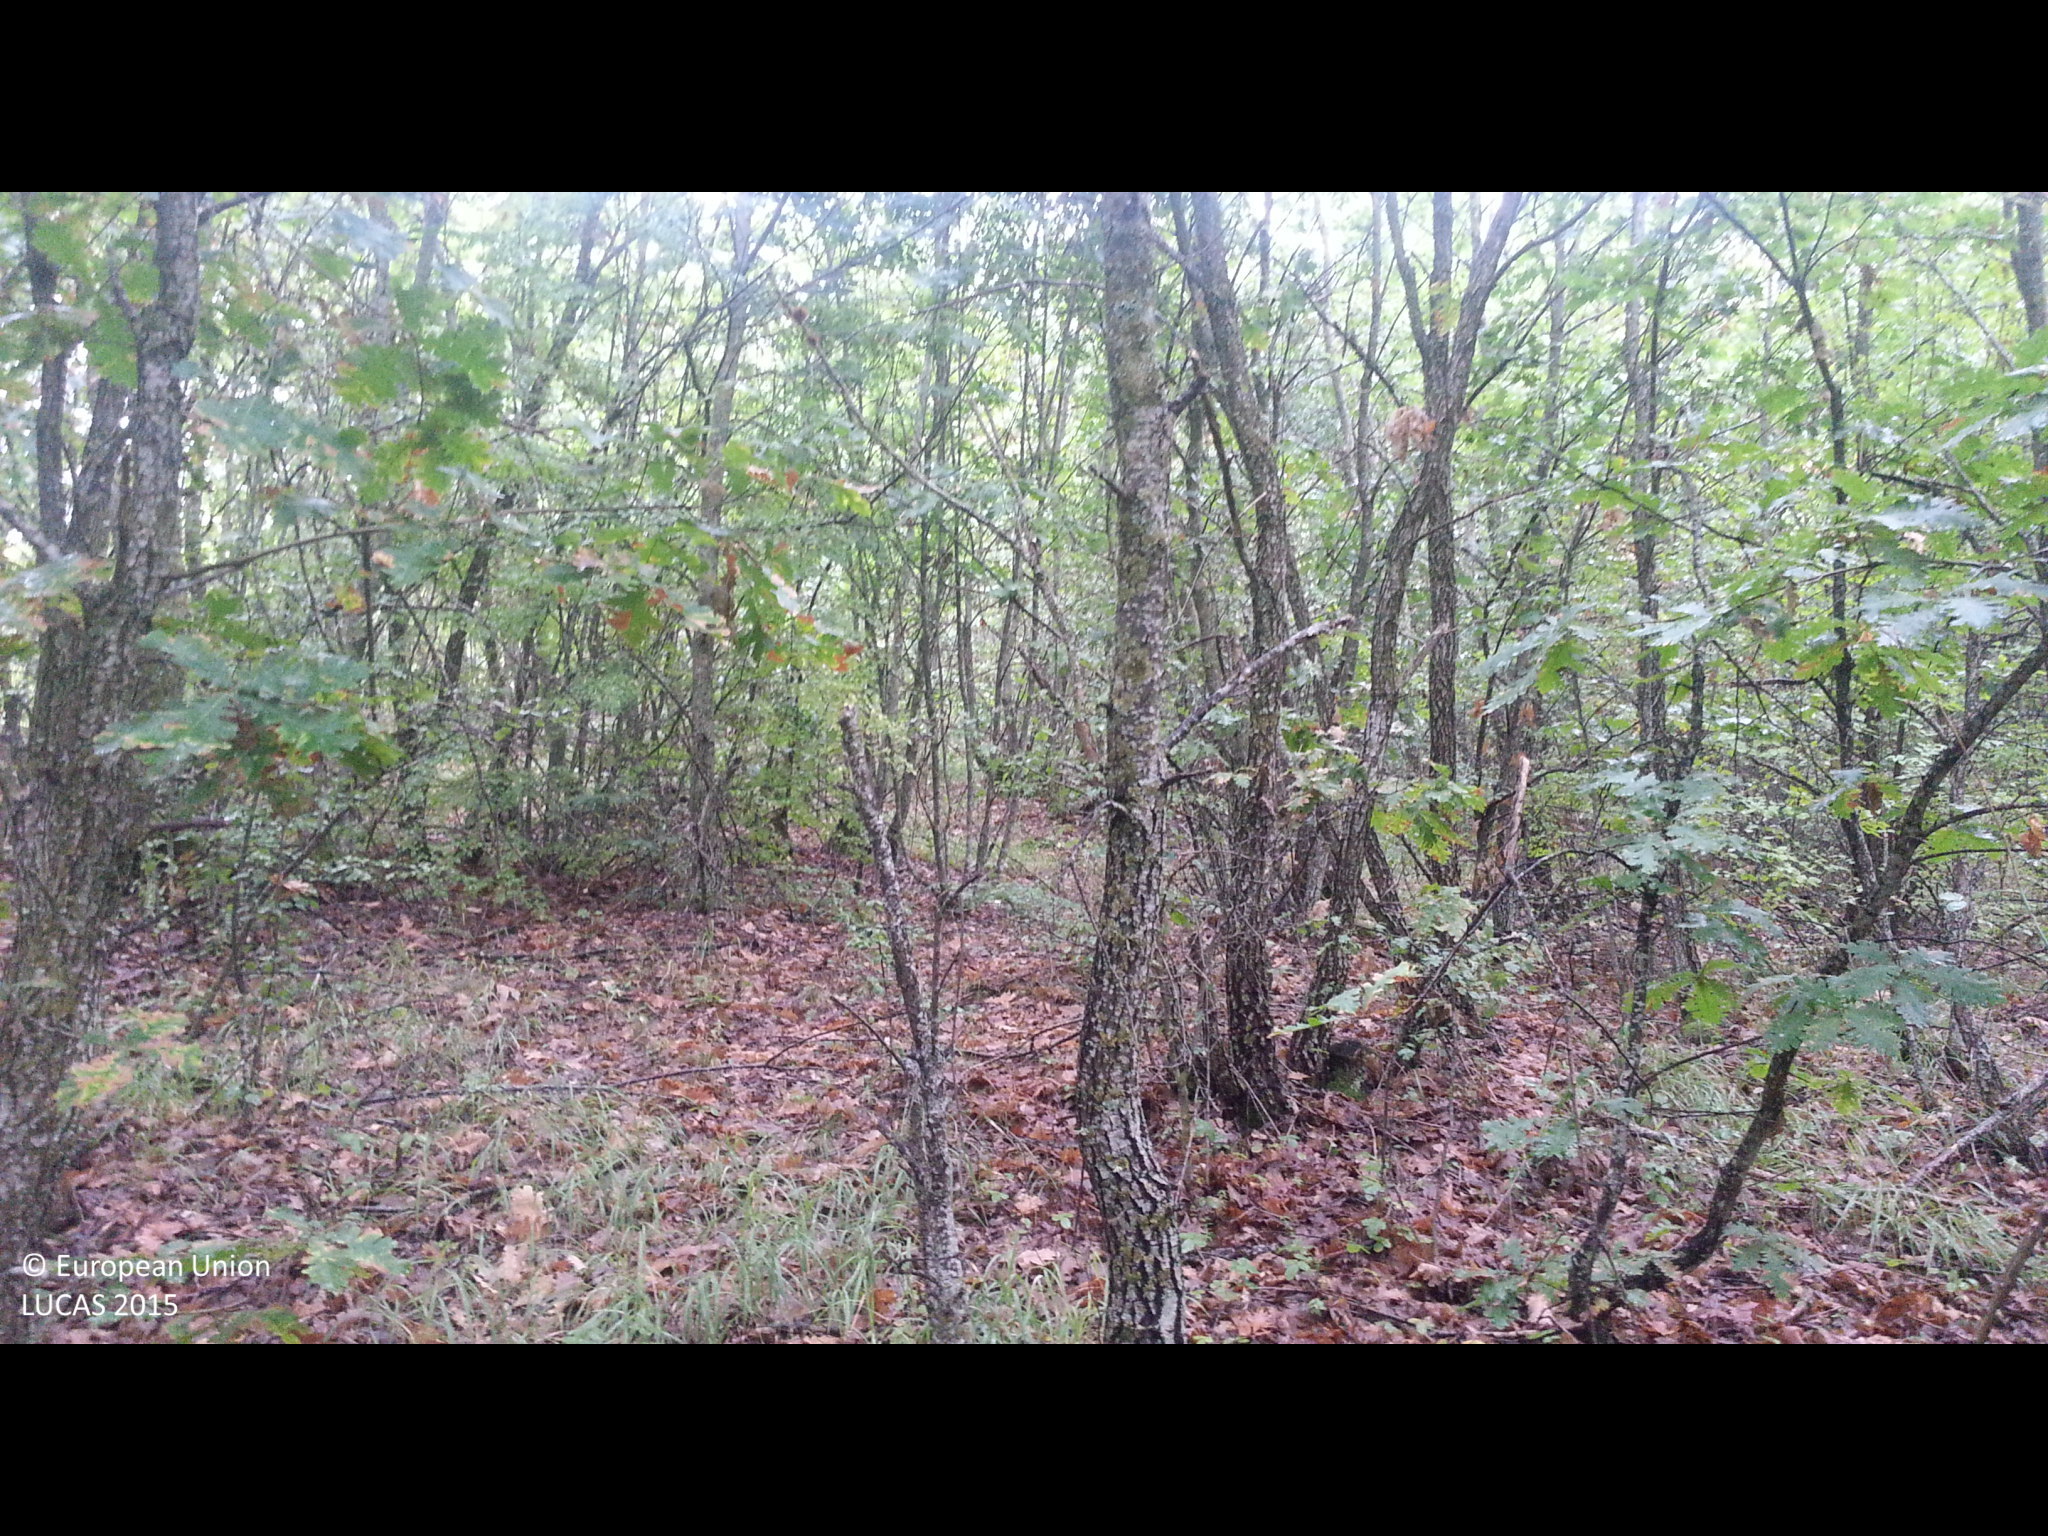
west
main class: Woodland
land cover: Broadleaved woodland
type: mesophytic deciduous forest
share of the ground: > 75 %
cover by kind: broadleaved forest trees 85 %, shrubs 15 %
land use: Forestry
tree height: < 5 m
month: September
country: BG
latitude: 42.5239
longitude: 22.7210
